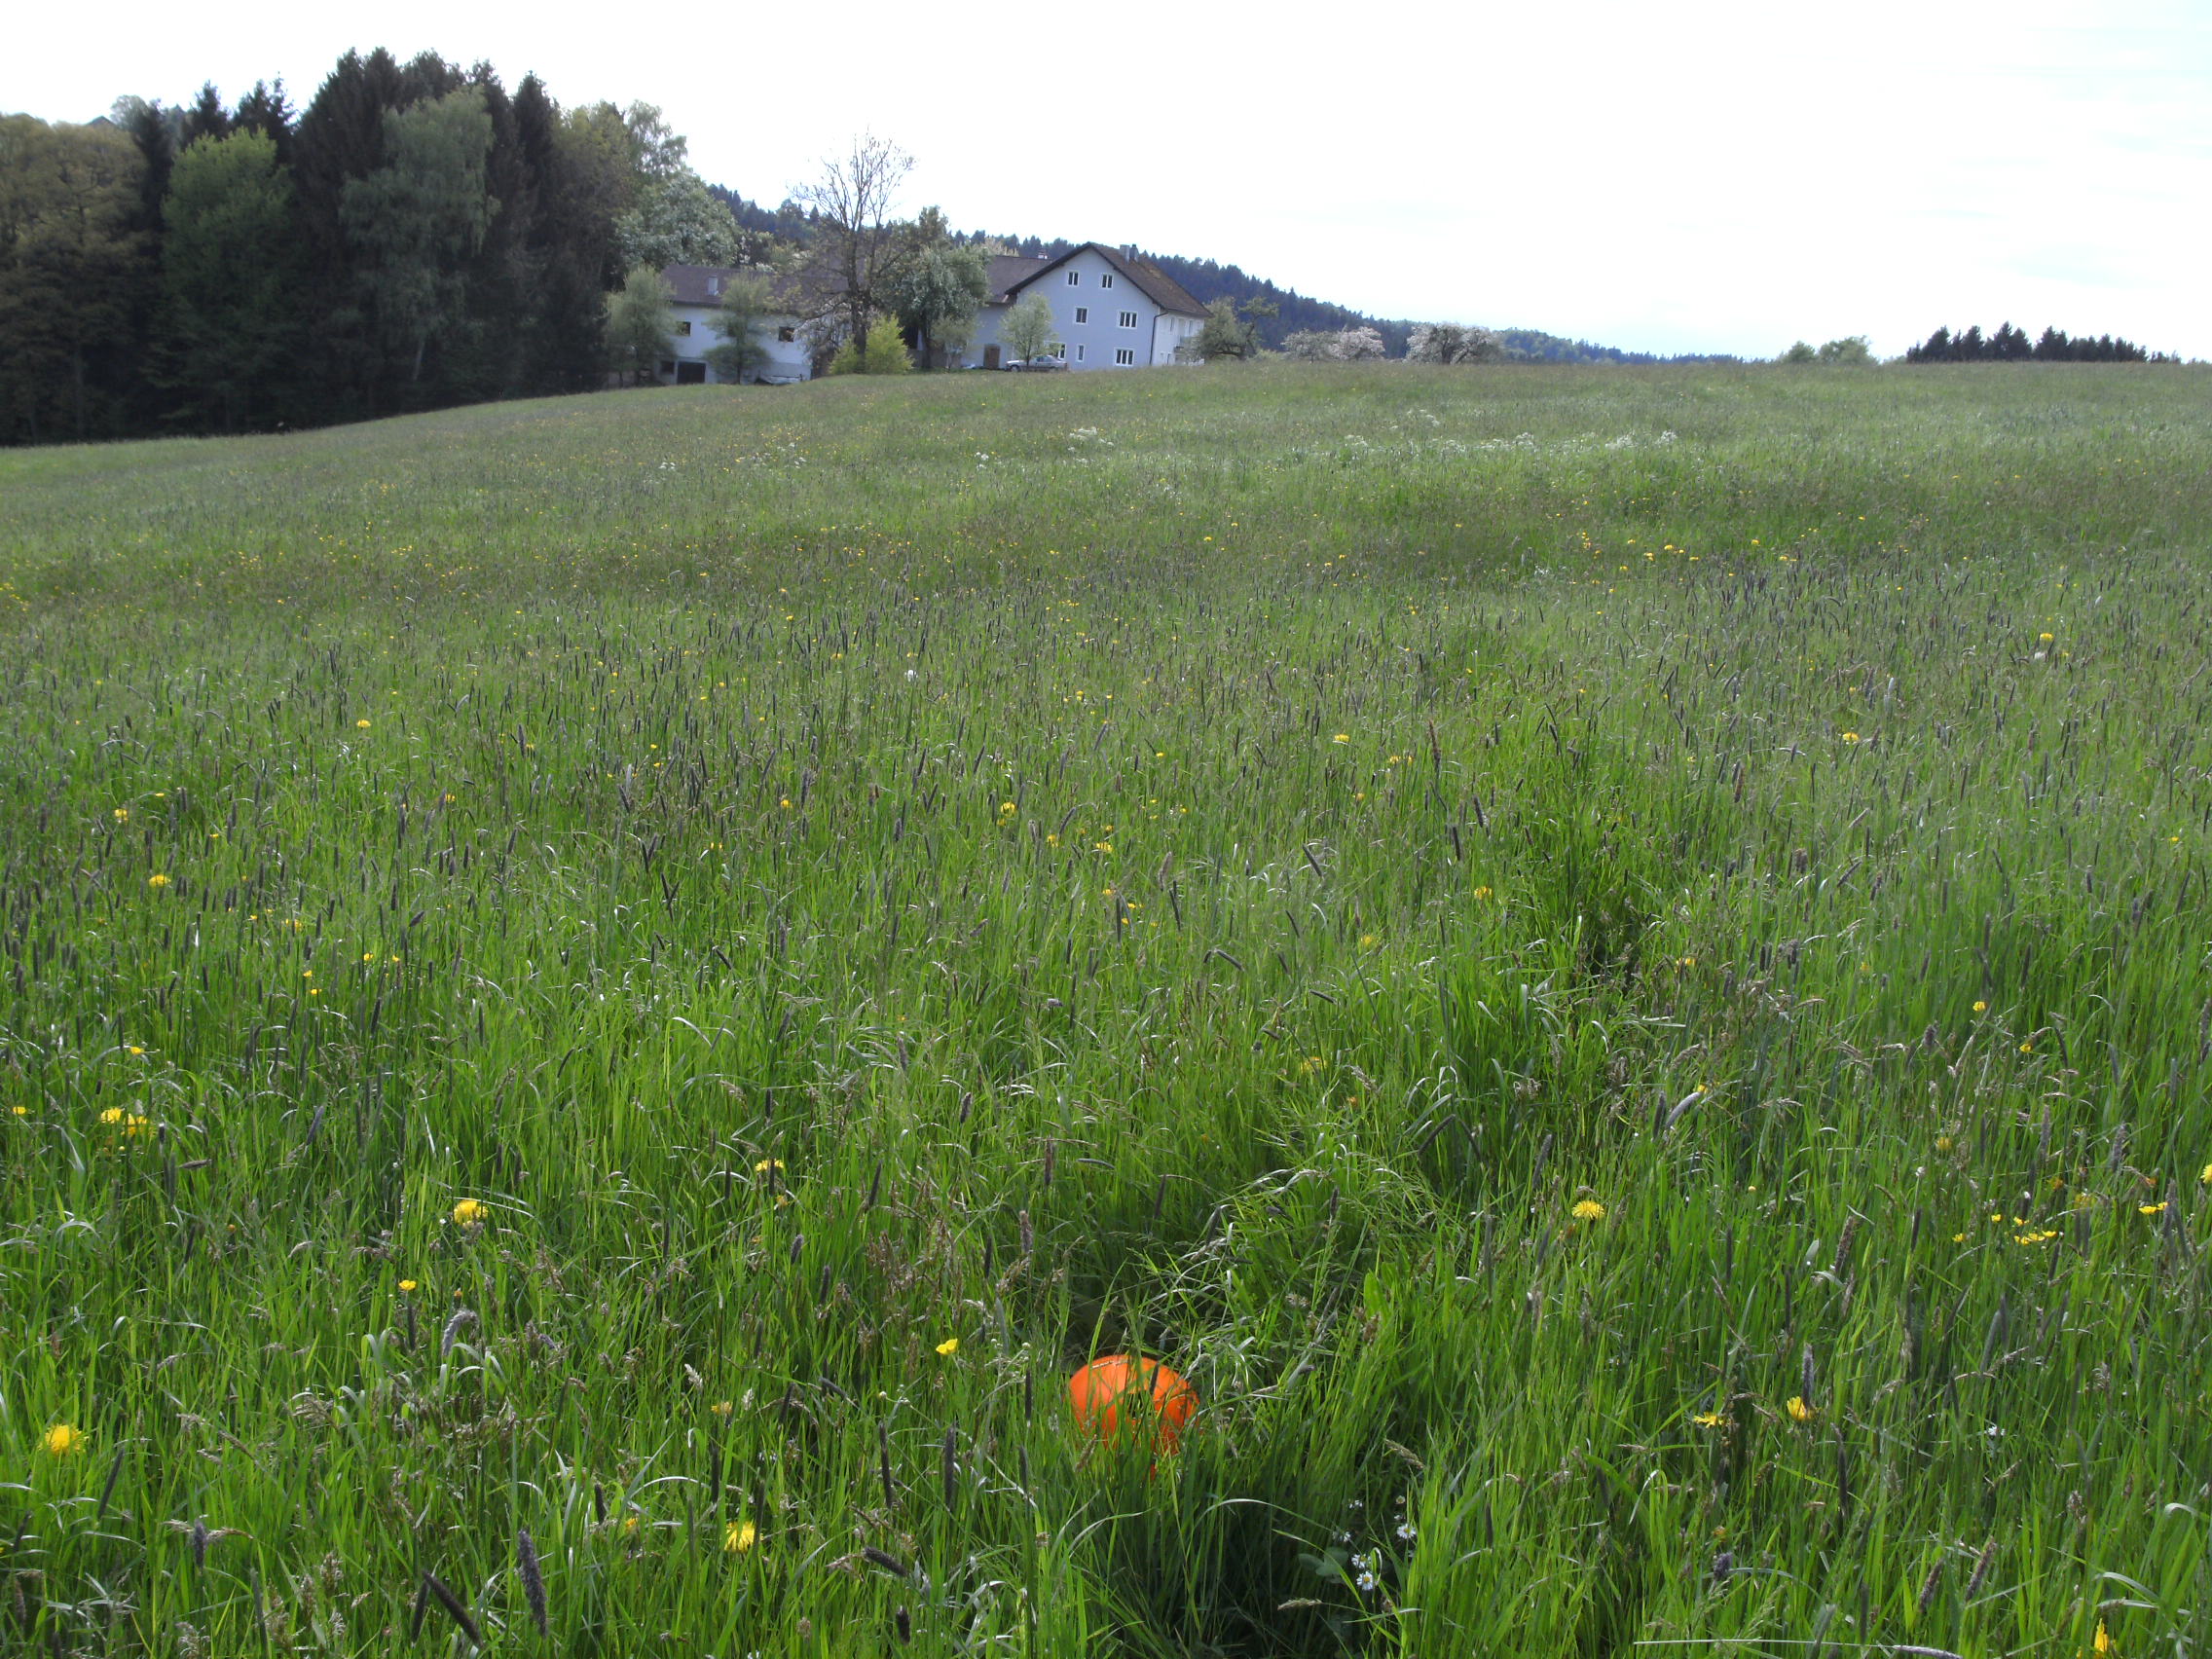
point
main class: Grassland
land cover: Grassland without tree/shrub cover
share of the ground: > 75 %
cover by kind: herbaceous plants 100 %
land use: Agriculture (excluding fallow land and kitchen gardens)
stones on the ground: < 10 %
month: May
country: AT
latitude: 48.1360
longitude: 13.3720
